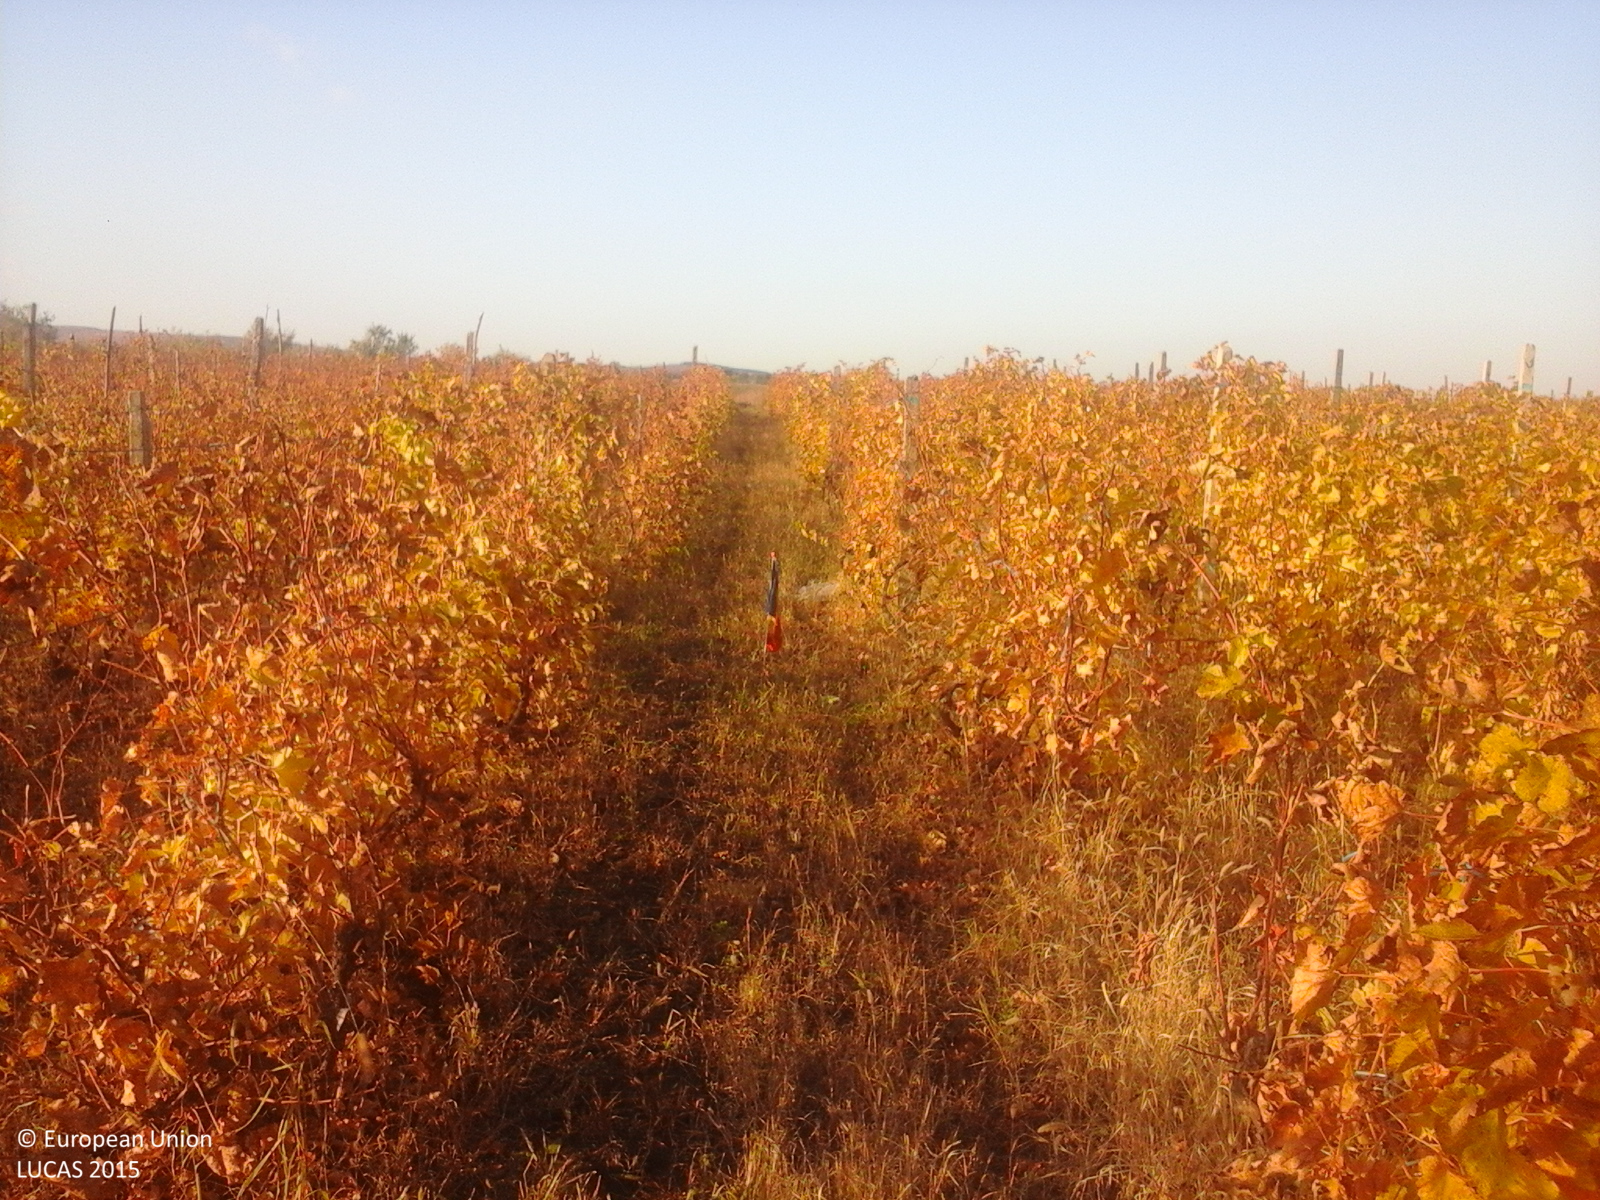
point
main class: Cropland
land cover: Vineyards
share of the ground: > 75 %
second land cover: Other bare soil
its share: > 75 %
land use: Agriculture (excluding fallow land and kitchen gardens)
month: October
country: RO
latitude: 45.4857
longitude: 27.0415
